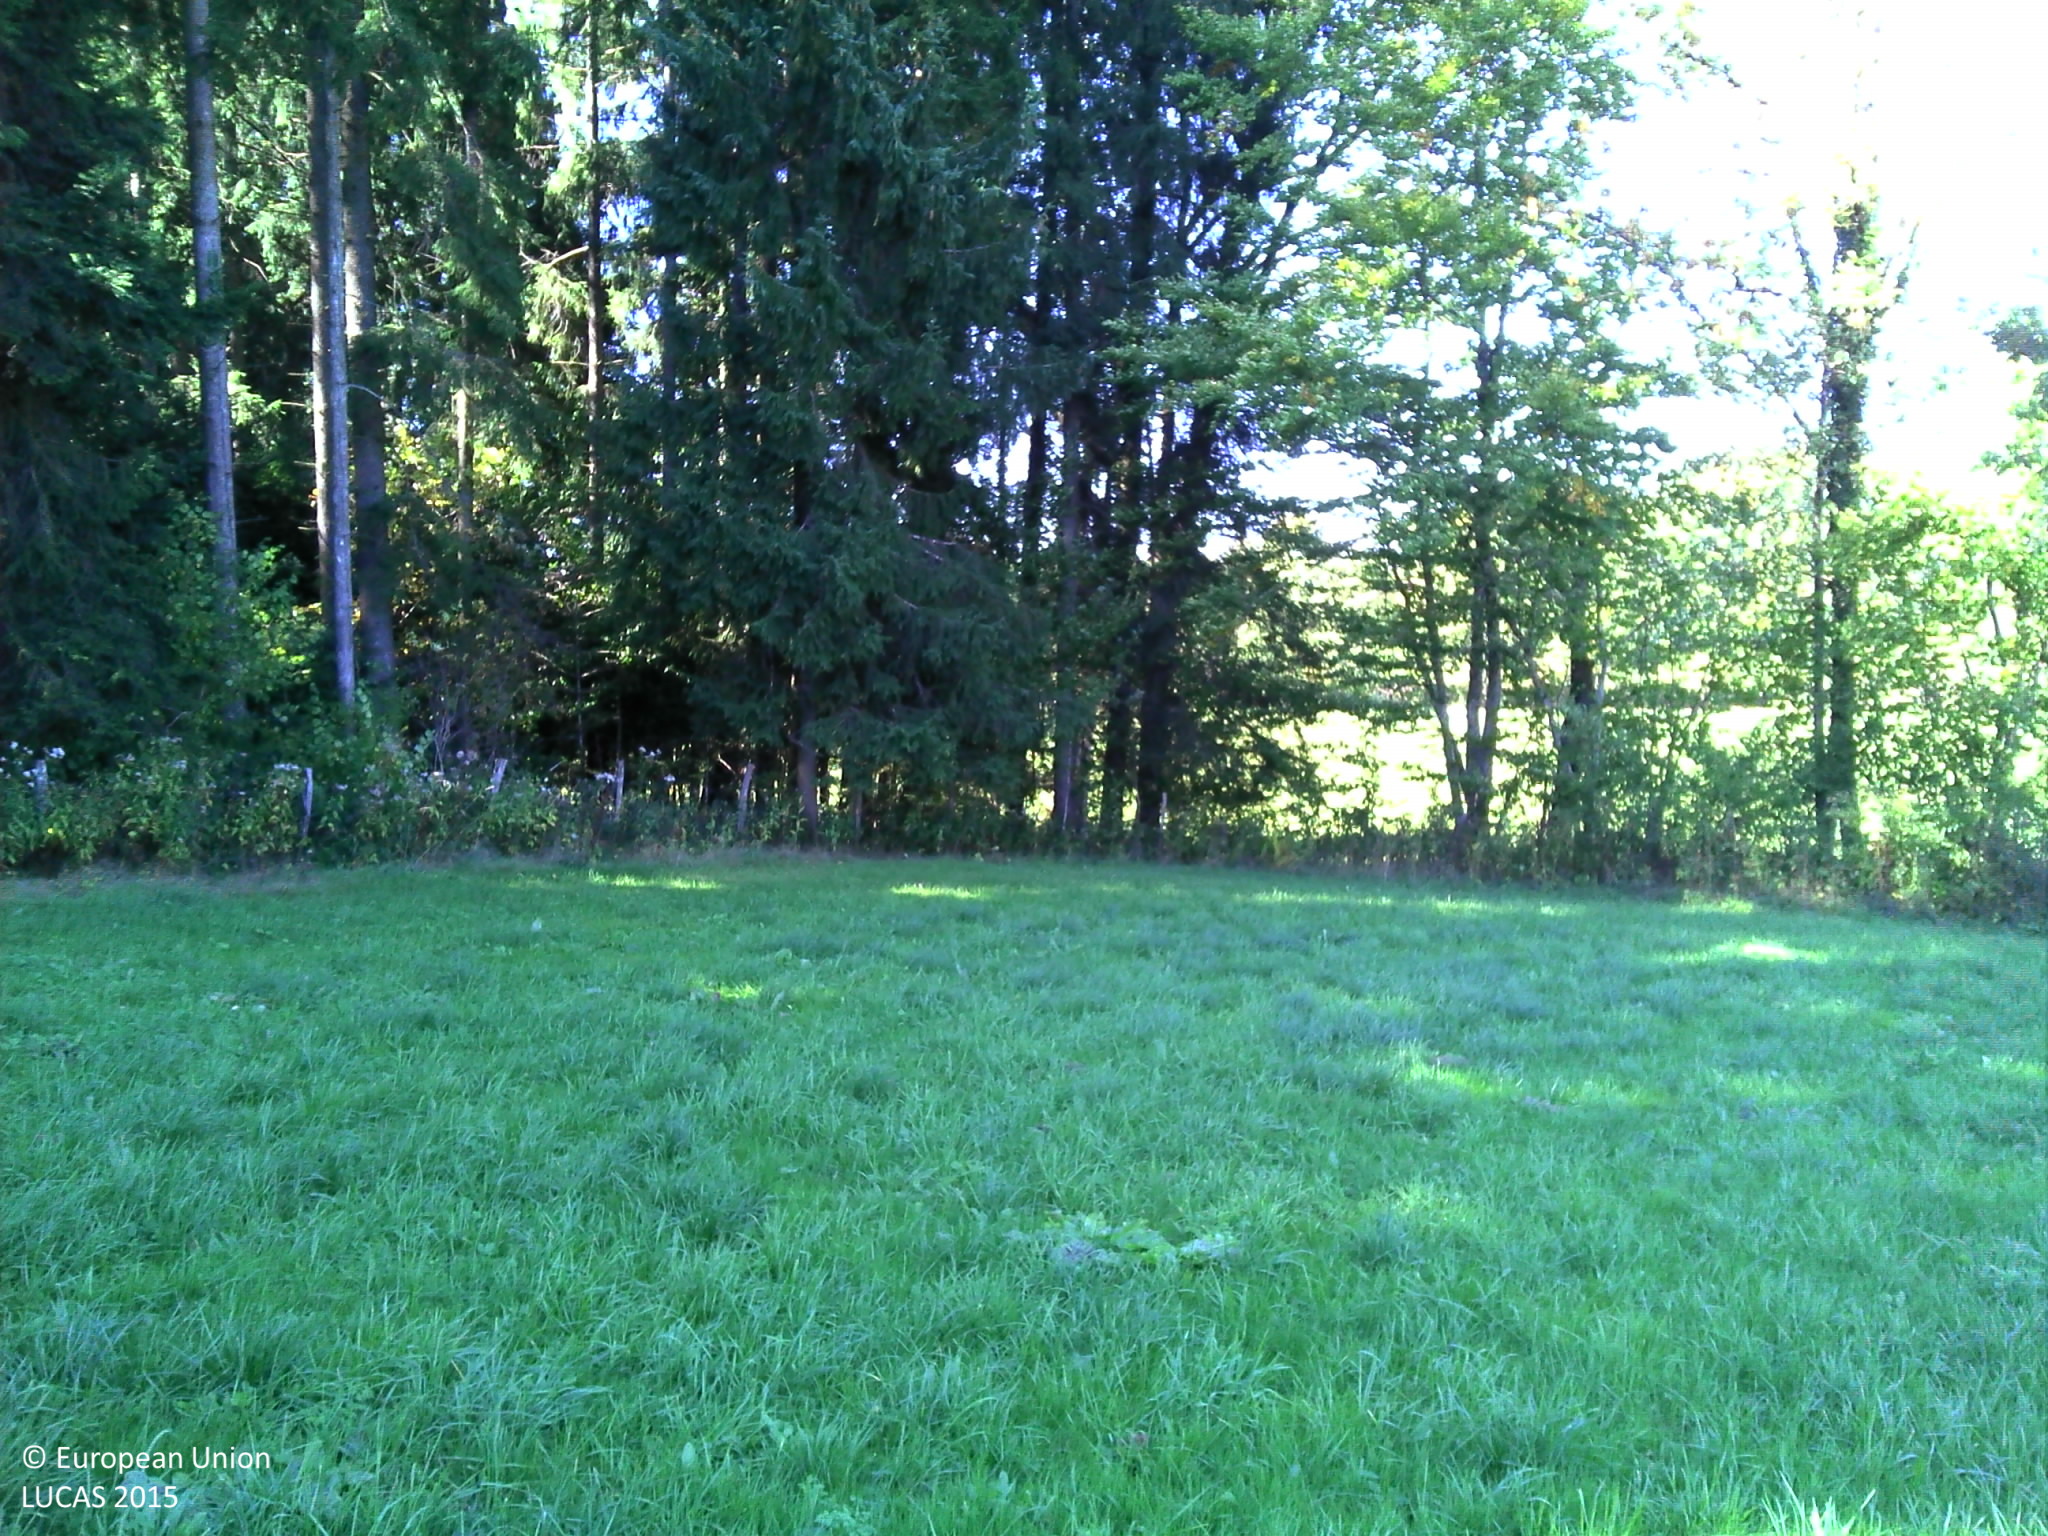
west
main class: Grassland
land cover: Grassland without tree/shrub cover
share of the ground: > 75 %
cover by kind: herbaceous plants 100 %
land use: Agriculture (excluding fallow land and kitchen gardens)
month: September
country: FR
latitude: 47.1455
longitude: 6.6395
